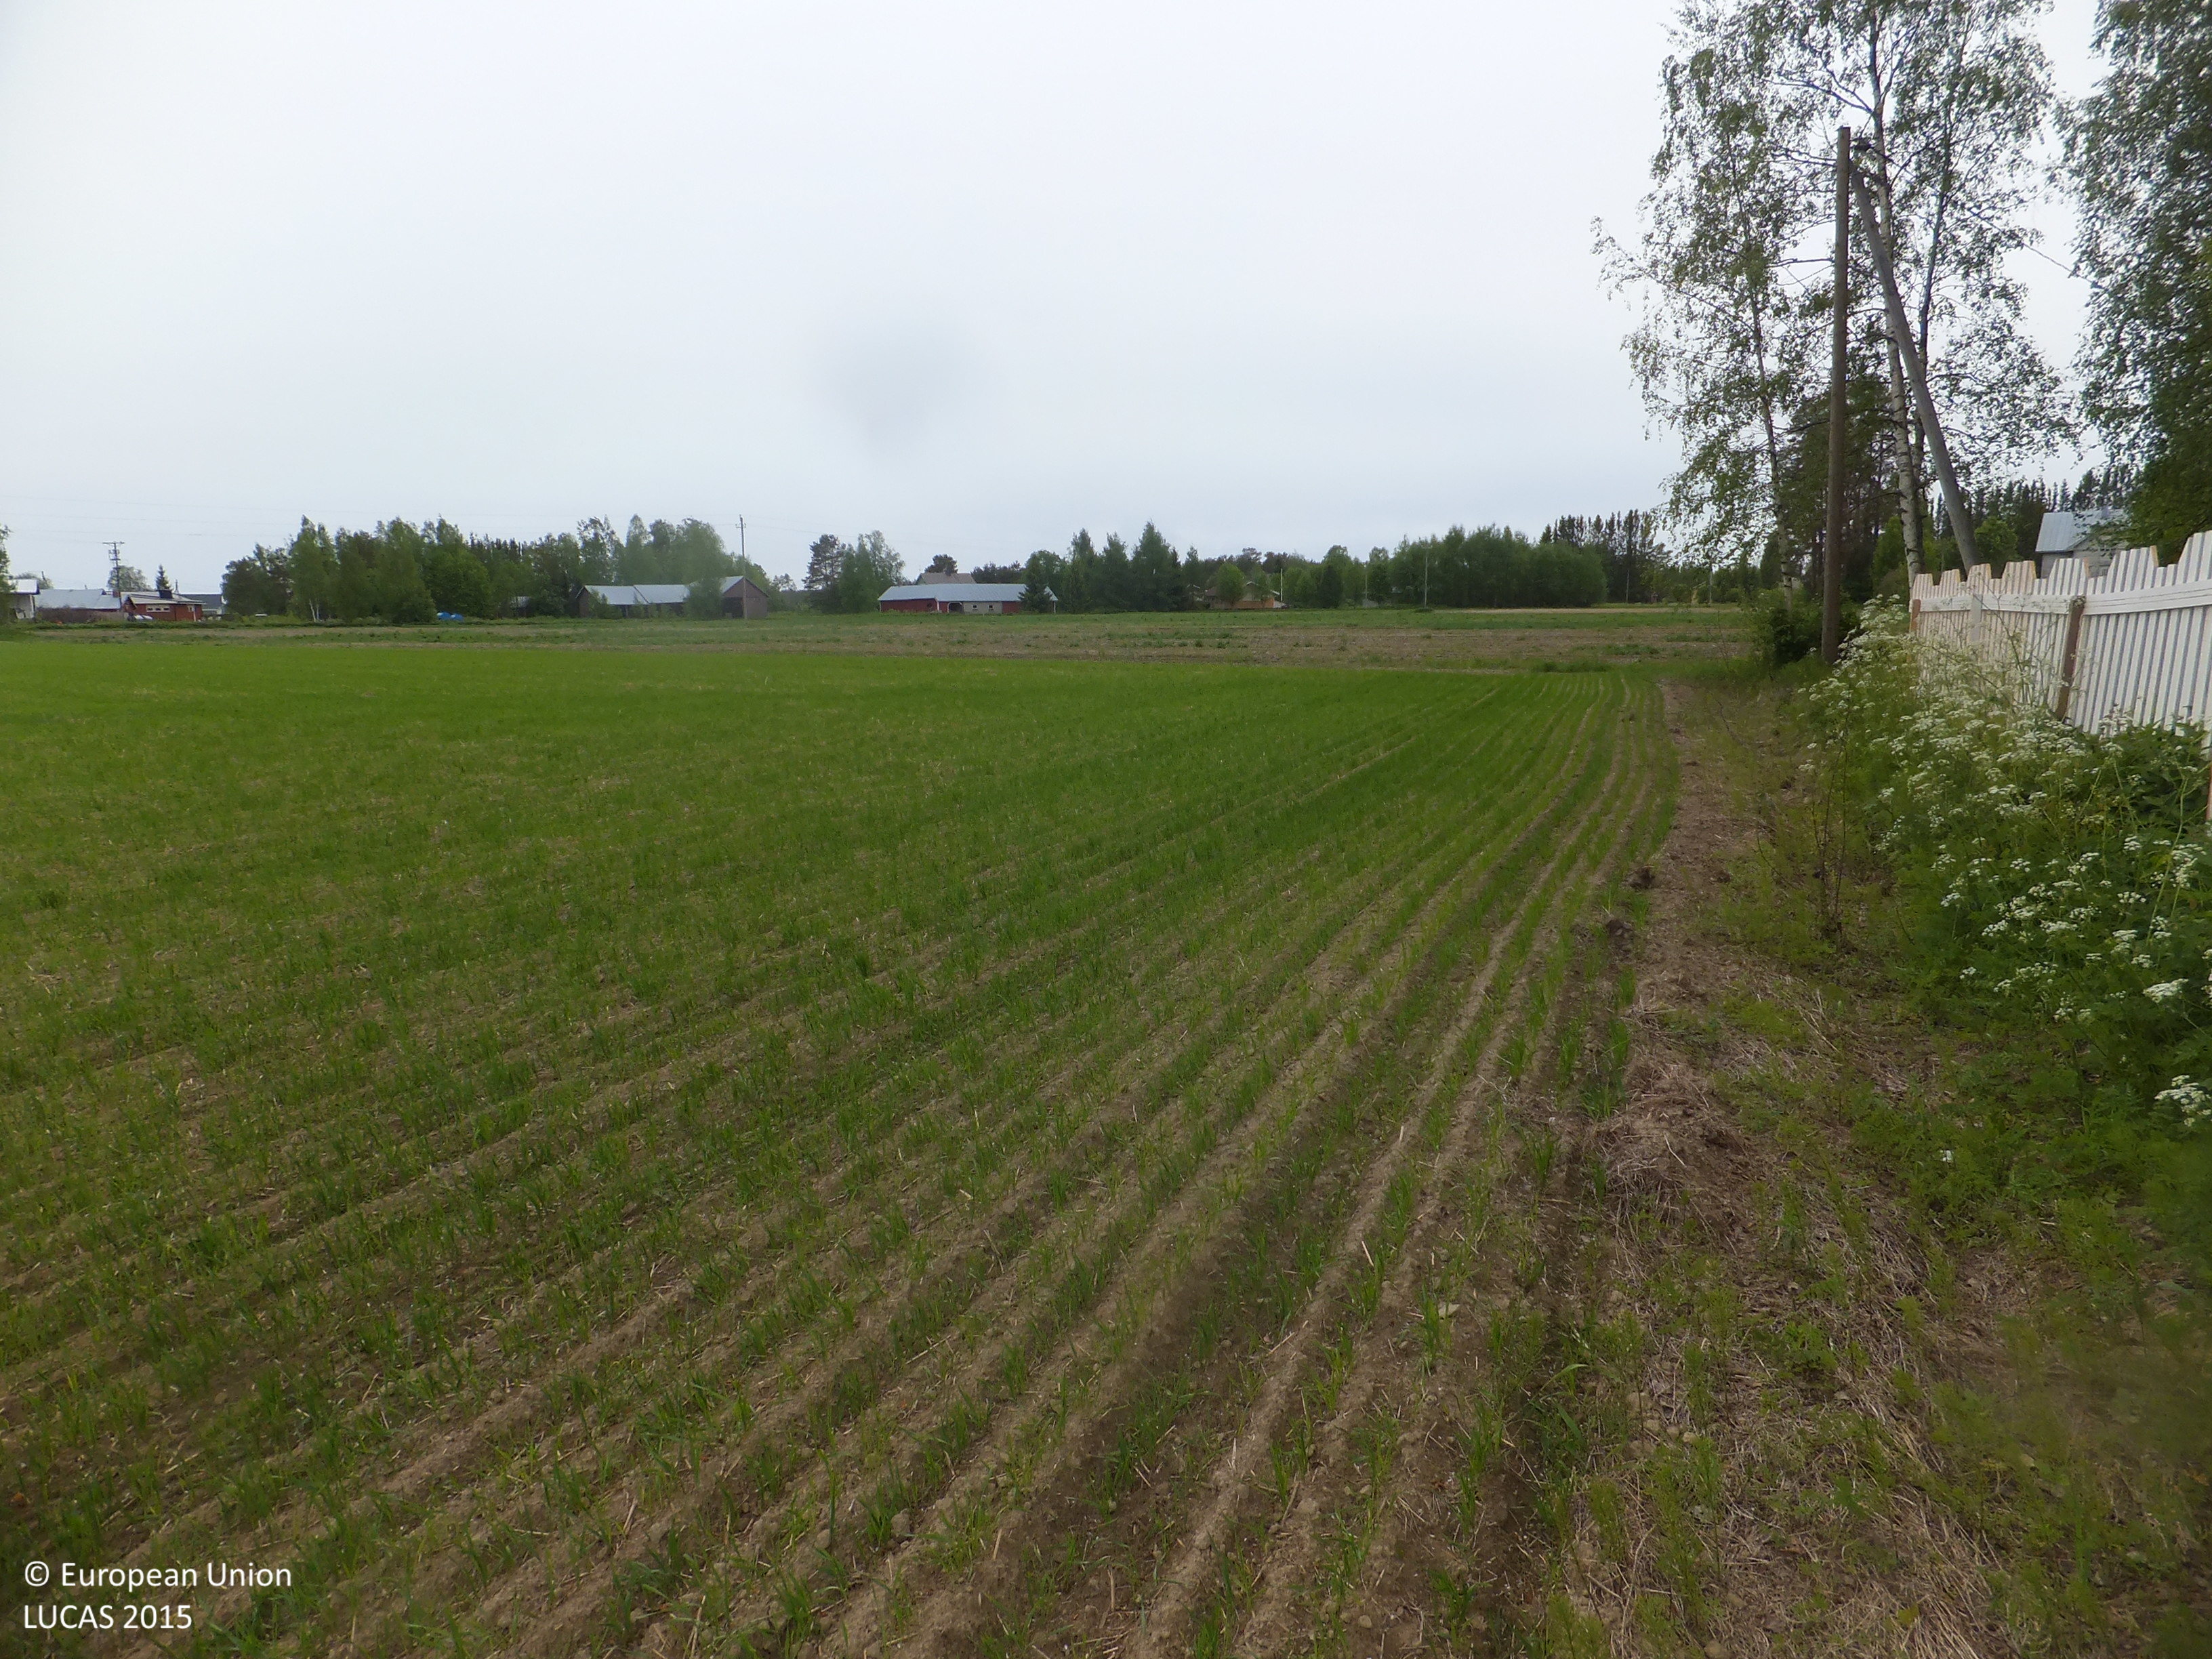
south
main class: Cropland
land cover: Common wheat
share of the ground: 10 - 25 %
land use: Agriculture (excluding fallow land and kitchen gardens)
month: June
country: FI
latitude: 63.2300
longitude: 22.6485
